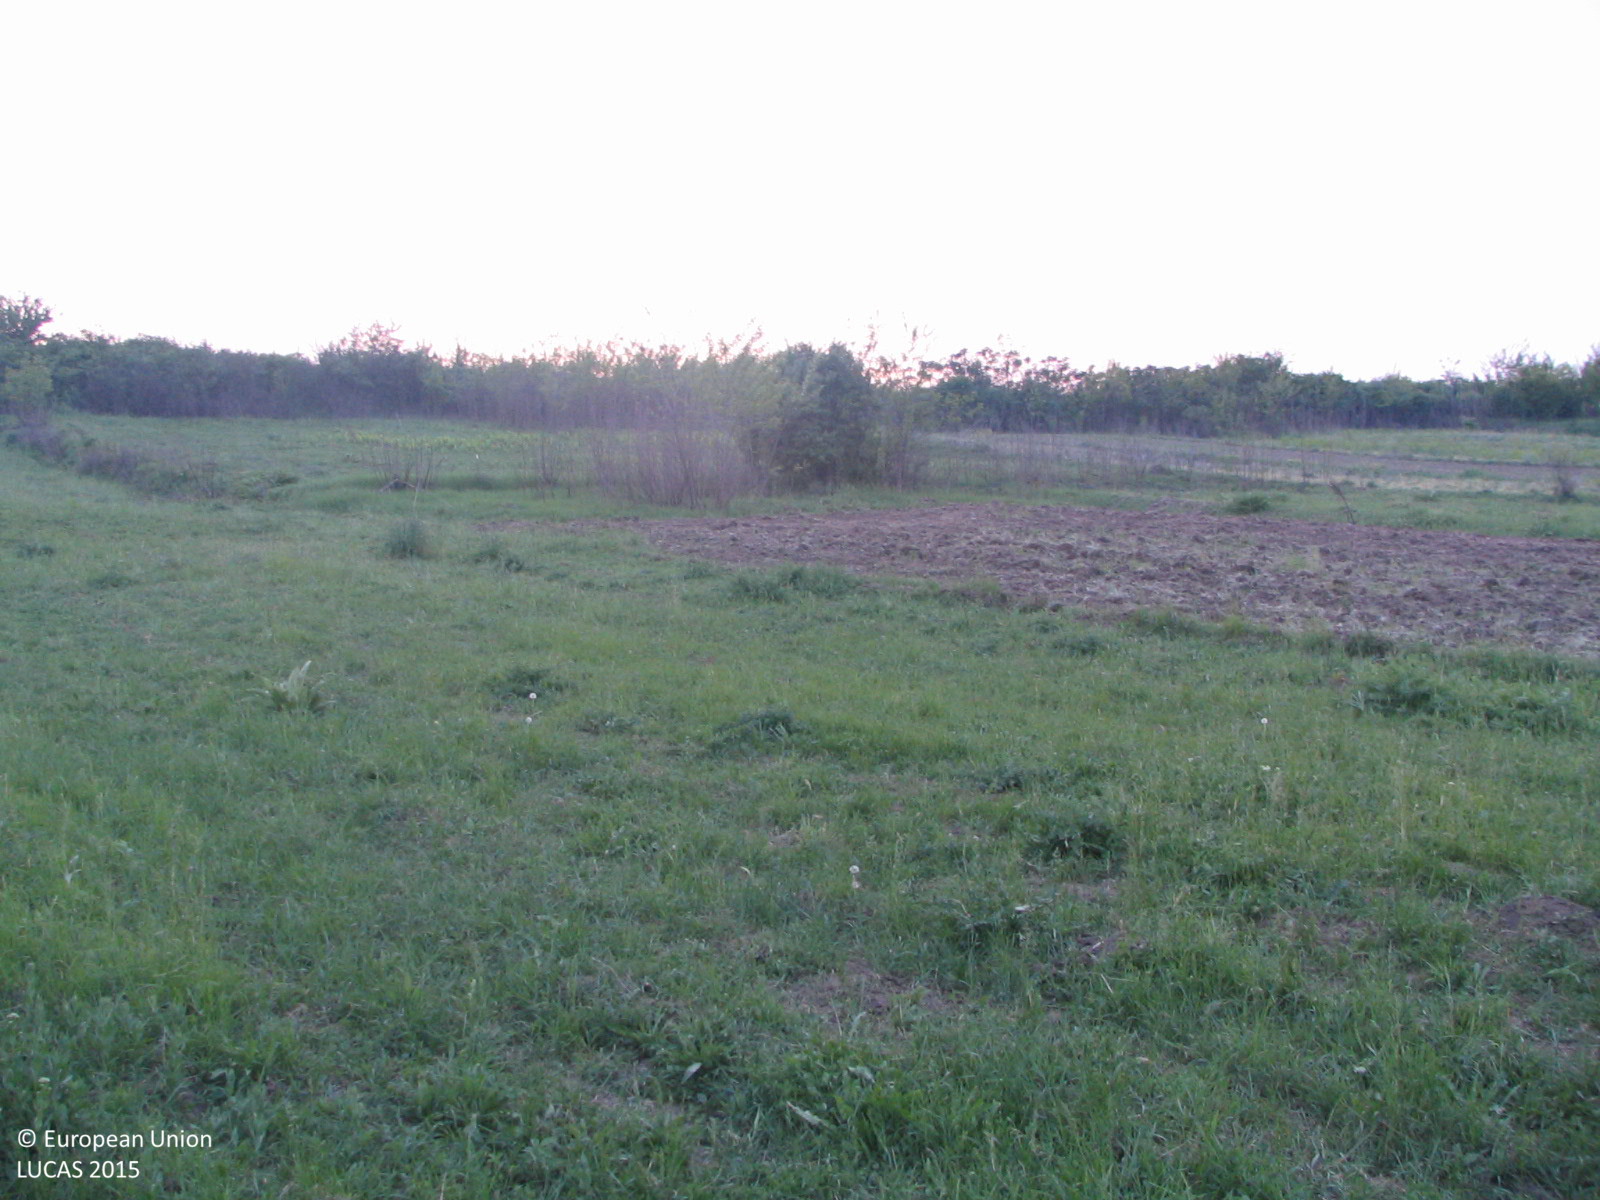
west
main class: Grassland
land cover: Grassland with sparse tree/shrub cover
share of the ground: > 75 %
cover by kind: herbaceous plants 90 %, broadleaved forest trees 5 %, shrubs 5 %
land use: Abandoned areas
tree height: > 5 m
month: May
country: BG
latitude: 43.6363
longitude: 23.8476
